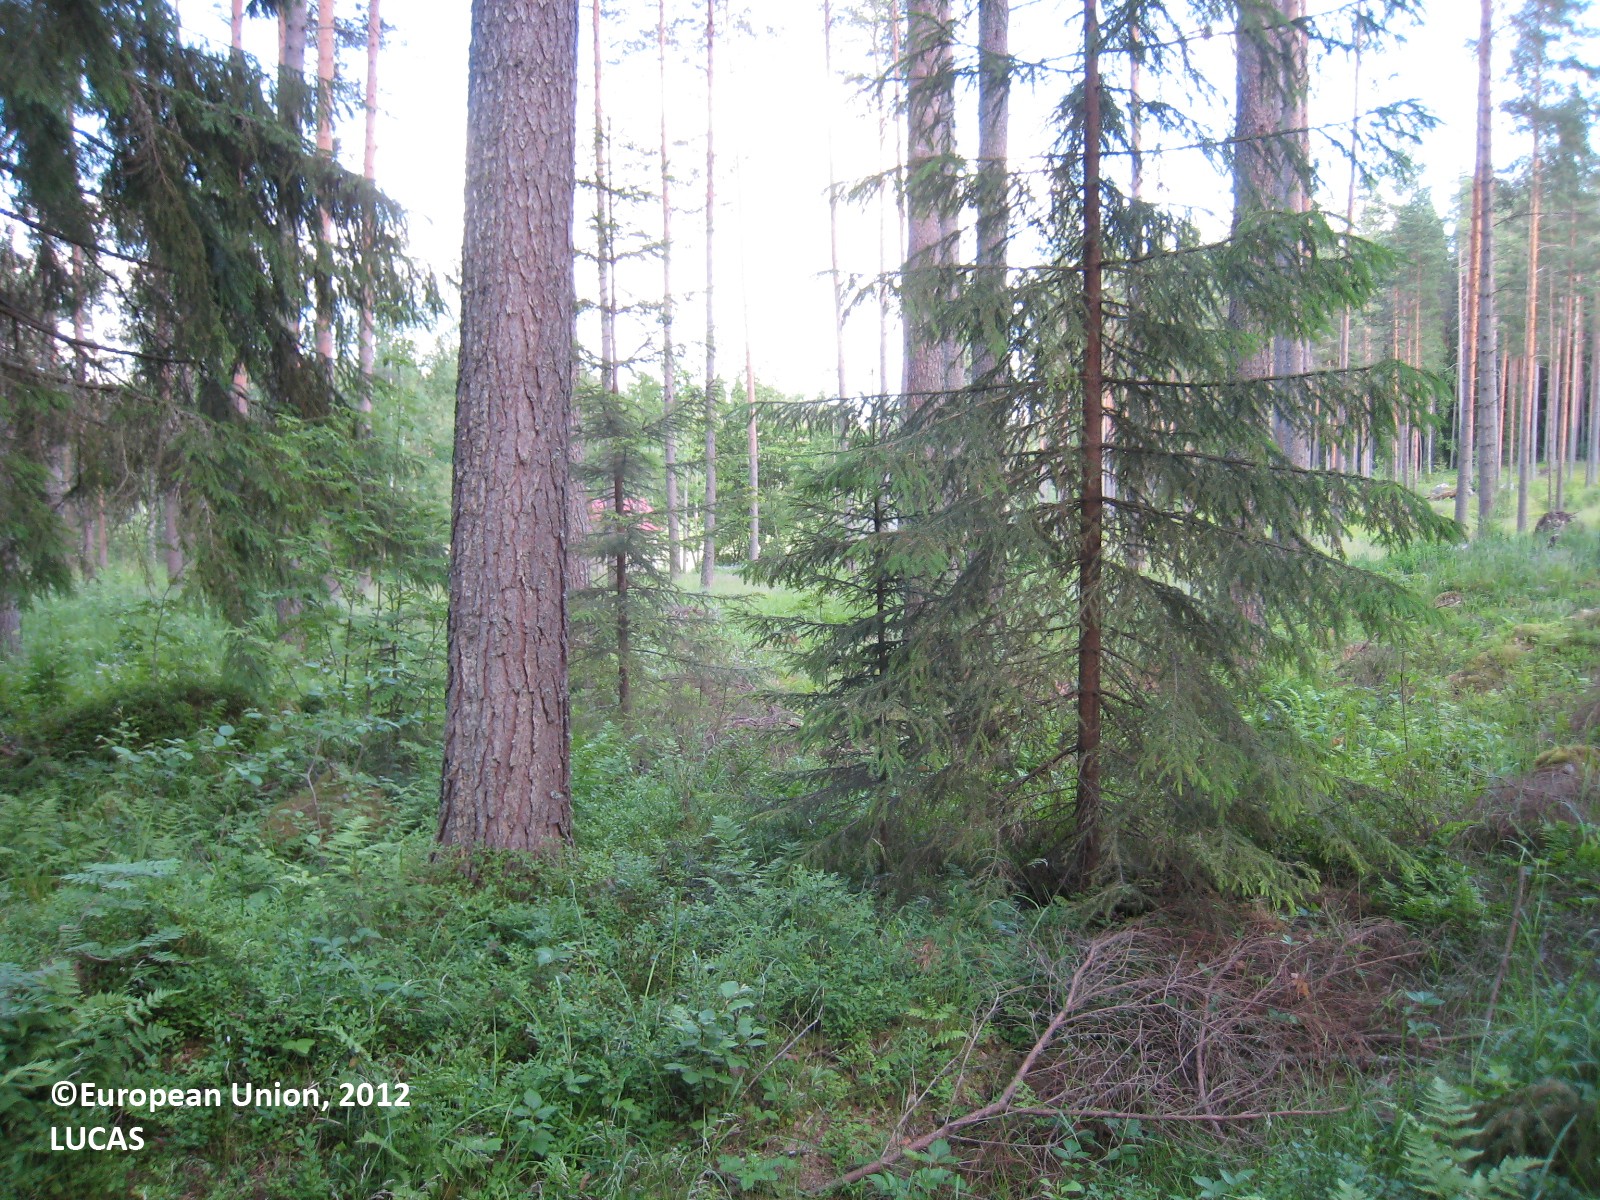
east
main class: Woodland
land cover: Other coniferous woodland
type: boreal forest
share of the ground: 50 - 75 %
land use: Forestry
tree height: > 5 m
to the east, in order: Other coniferous woodland; Pine dominated coniferous woodland; Tracks; Broadleaved woodland; Grassland without tree/shrub cover; Electric lines; Grassland without tree/shrub cover; Broadleaved woodland; Temporary grasslands
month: July
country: FI
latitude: 63.0665
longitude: 25.7653
